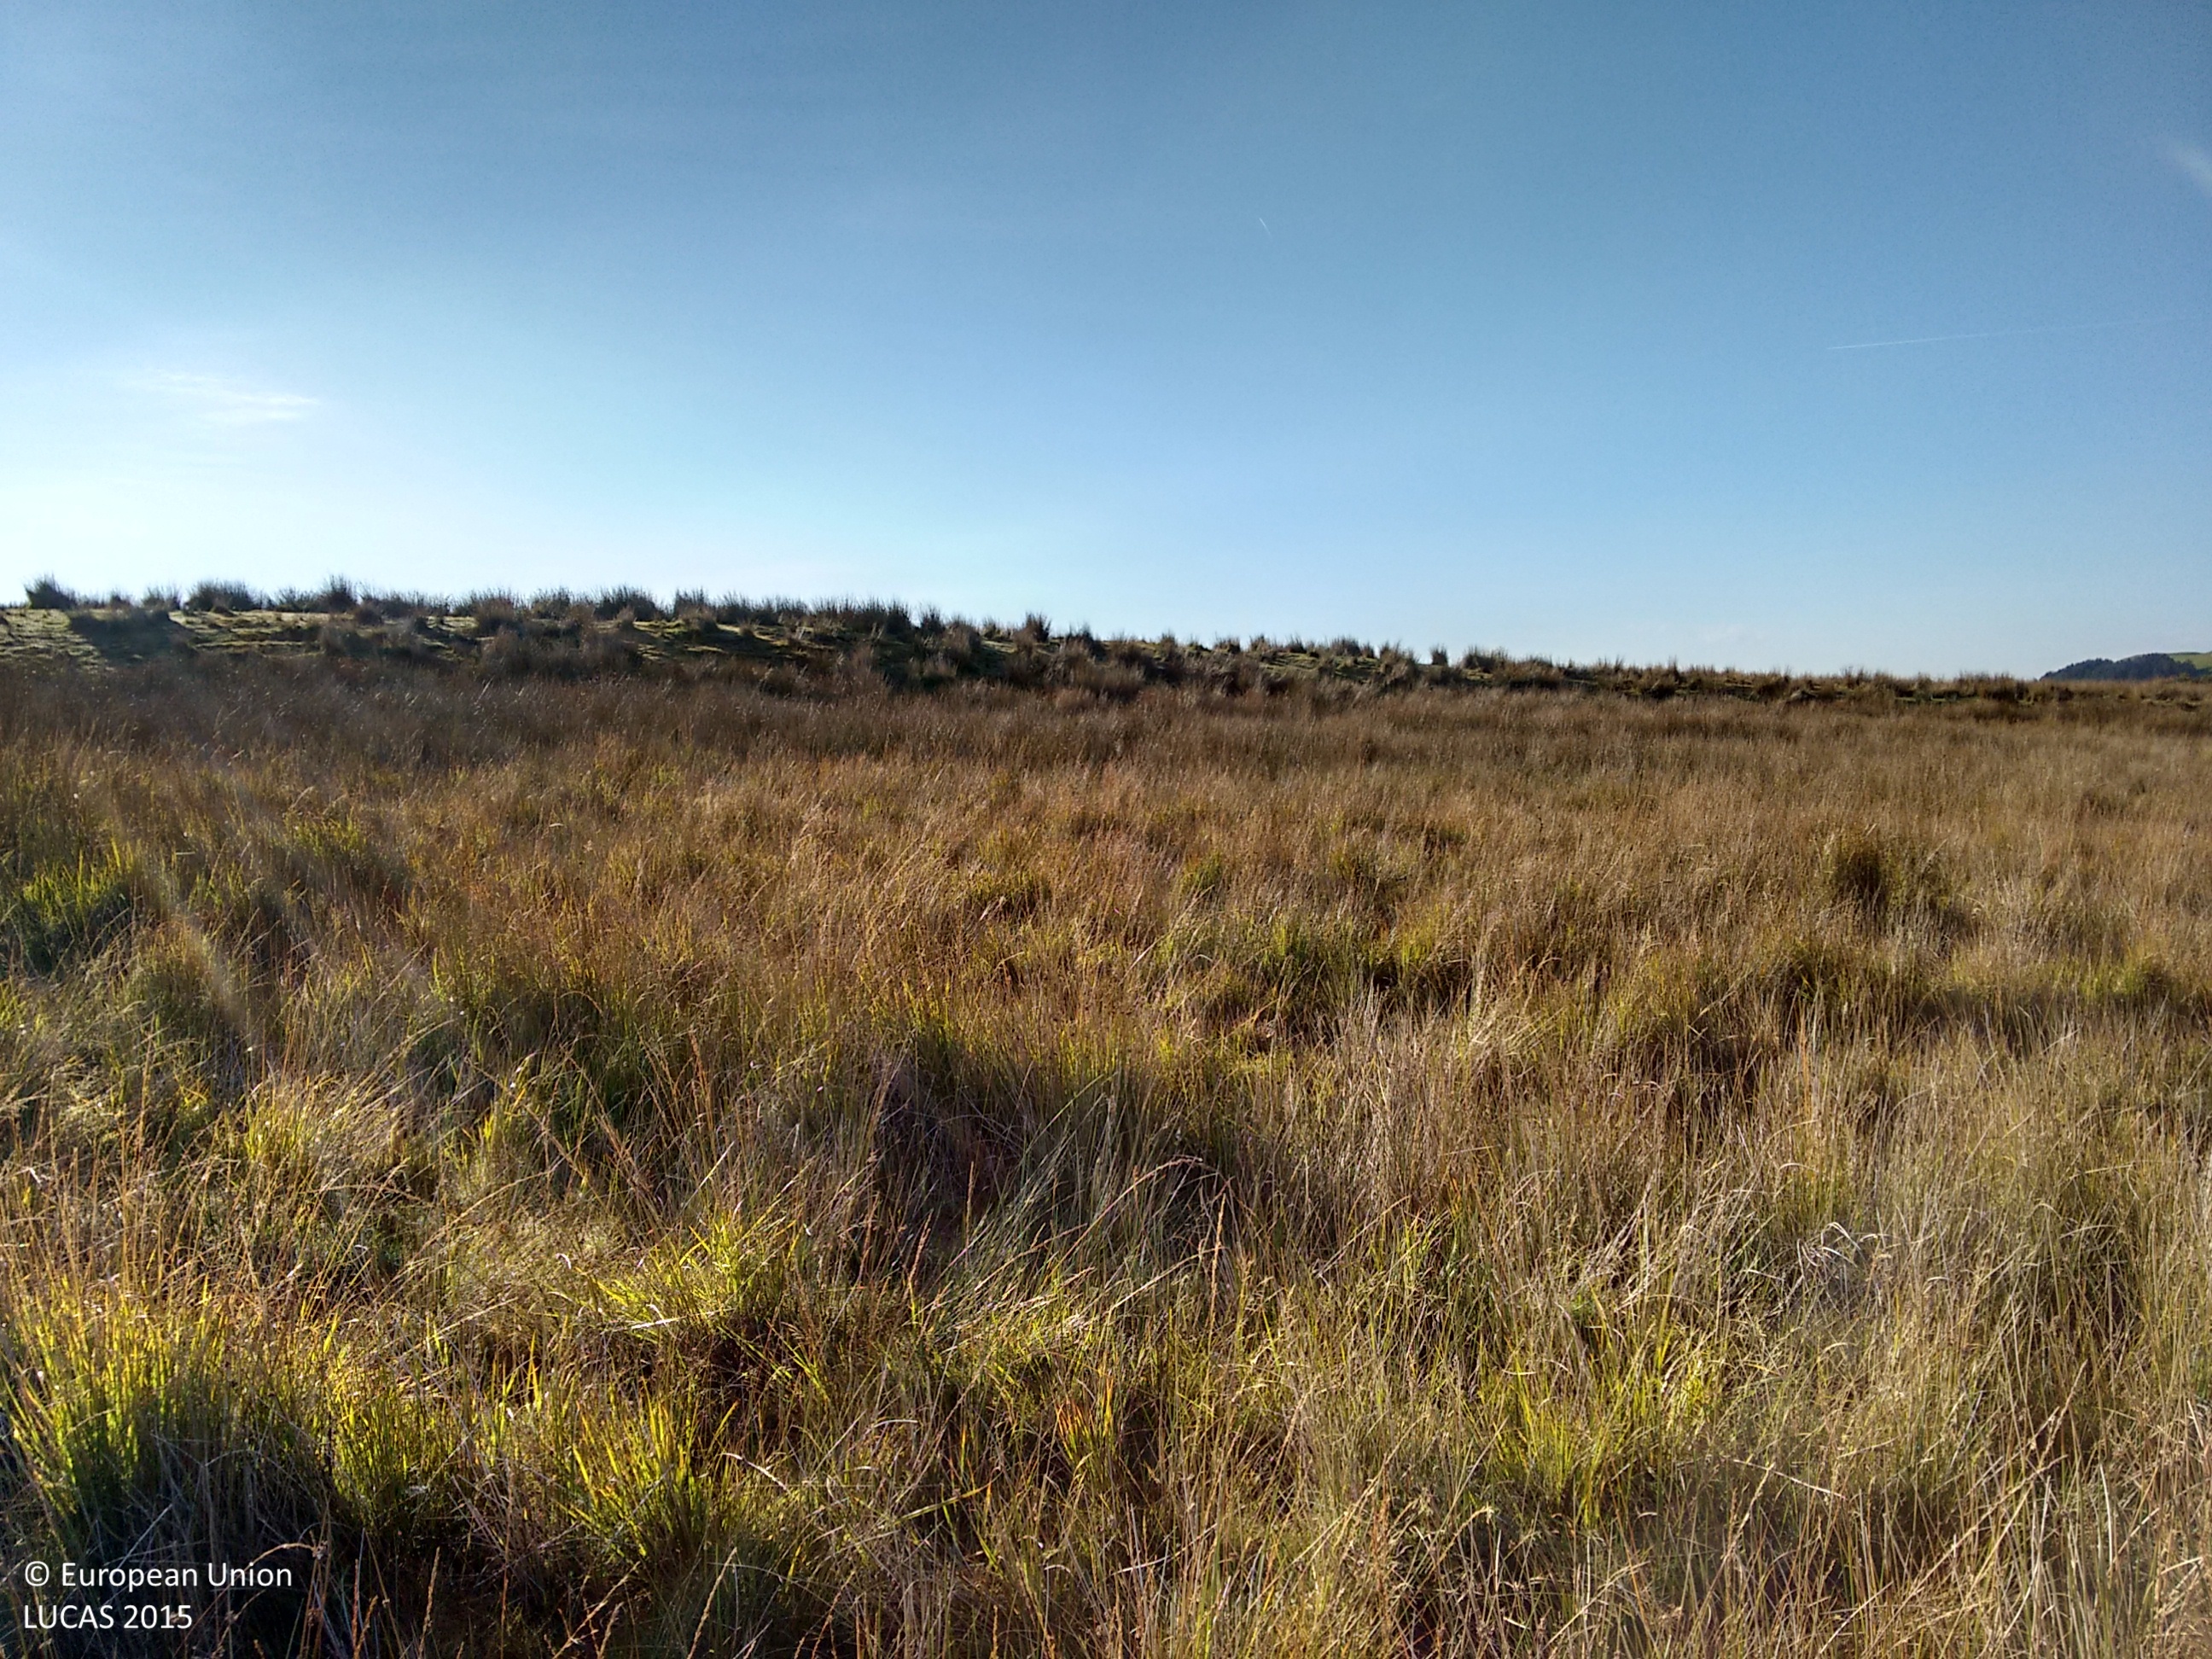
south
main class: Grassland
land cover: Grassland without tree/shrub cover
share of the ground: > 75 %
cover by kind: herbaceous plants 100 %
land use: Agriculture (excluding fallow land and kitchen gardens)
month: October
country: GB
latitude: 52.3633
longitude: -3.8515
